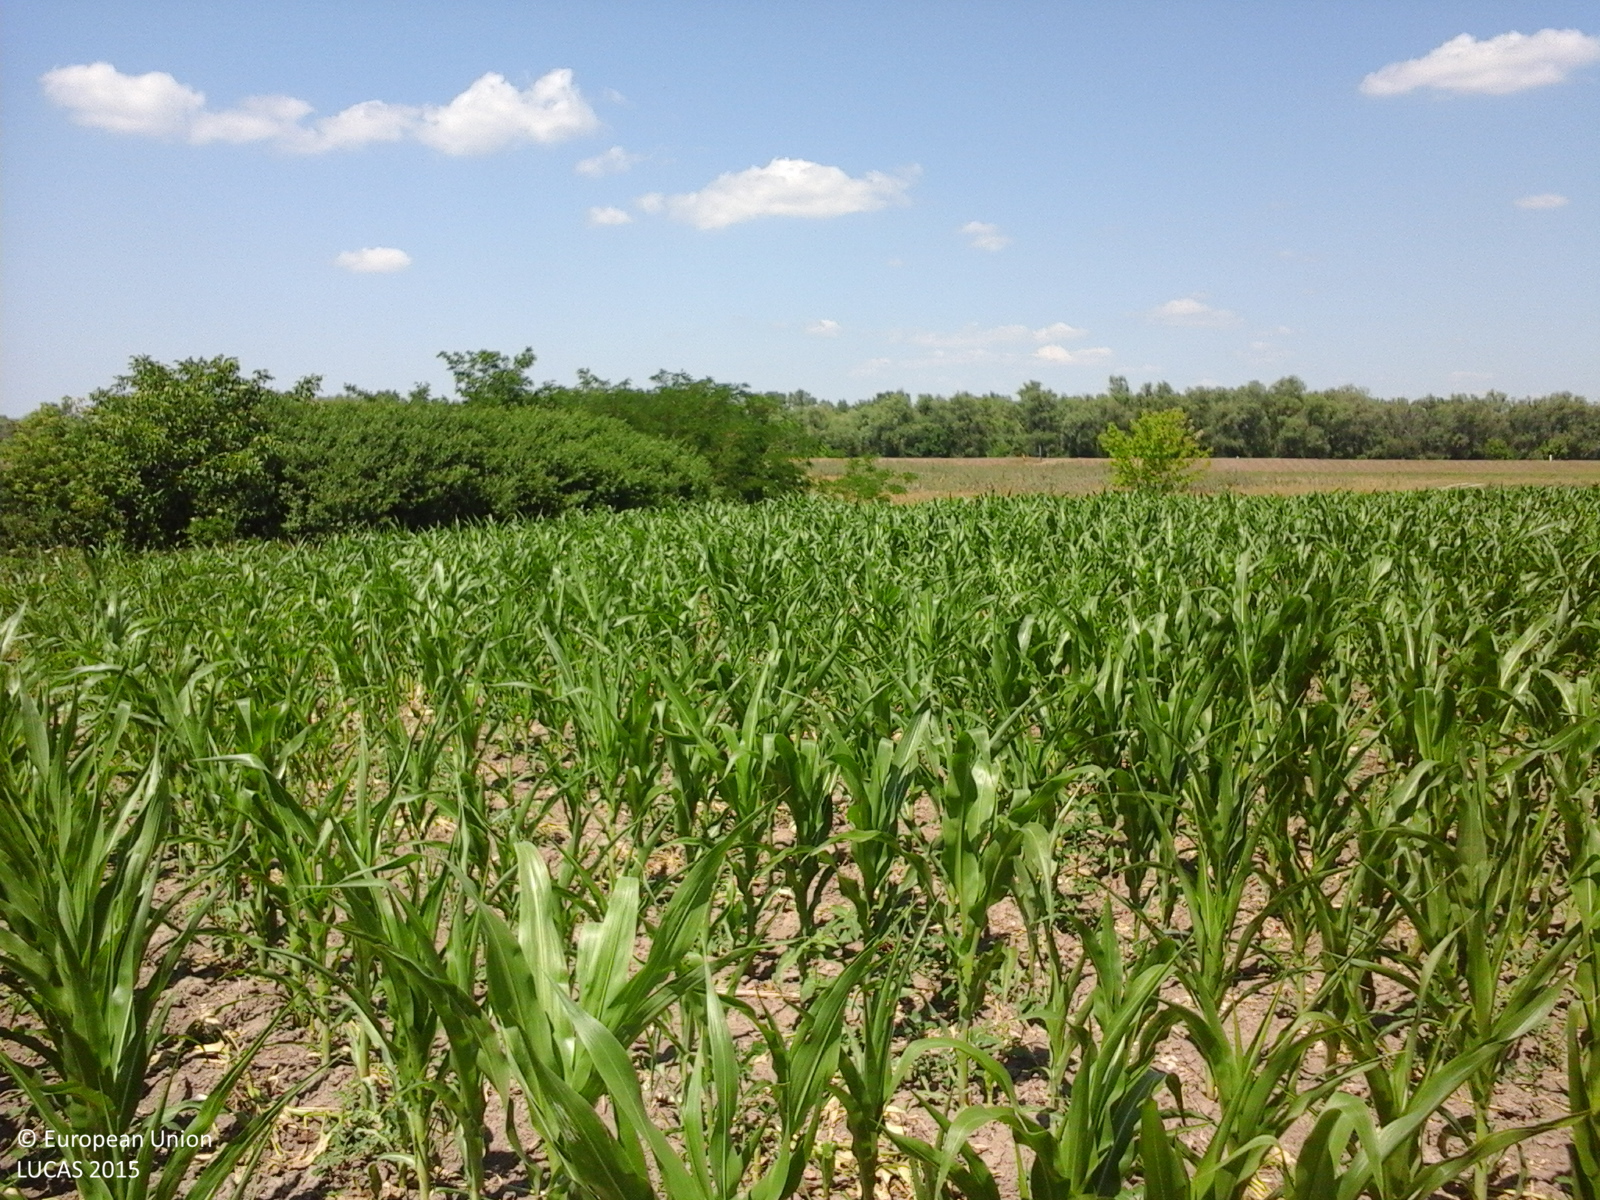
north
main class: Cropland
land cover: Maize
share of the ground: 25 - 50 %
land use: Agriculture (excluding fallow land and kitchen gardens)
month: June
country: RO
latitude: 47.4697
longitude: 27.5123
